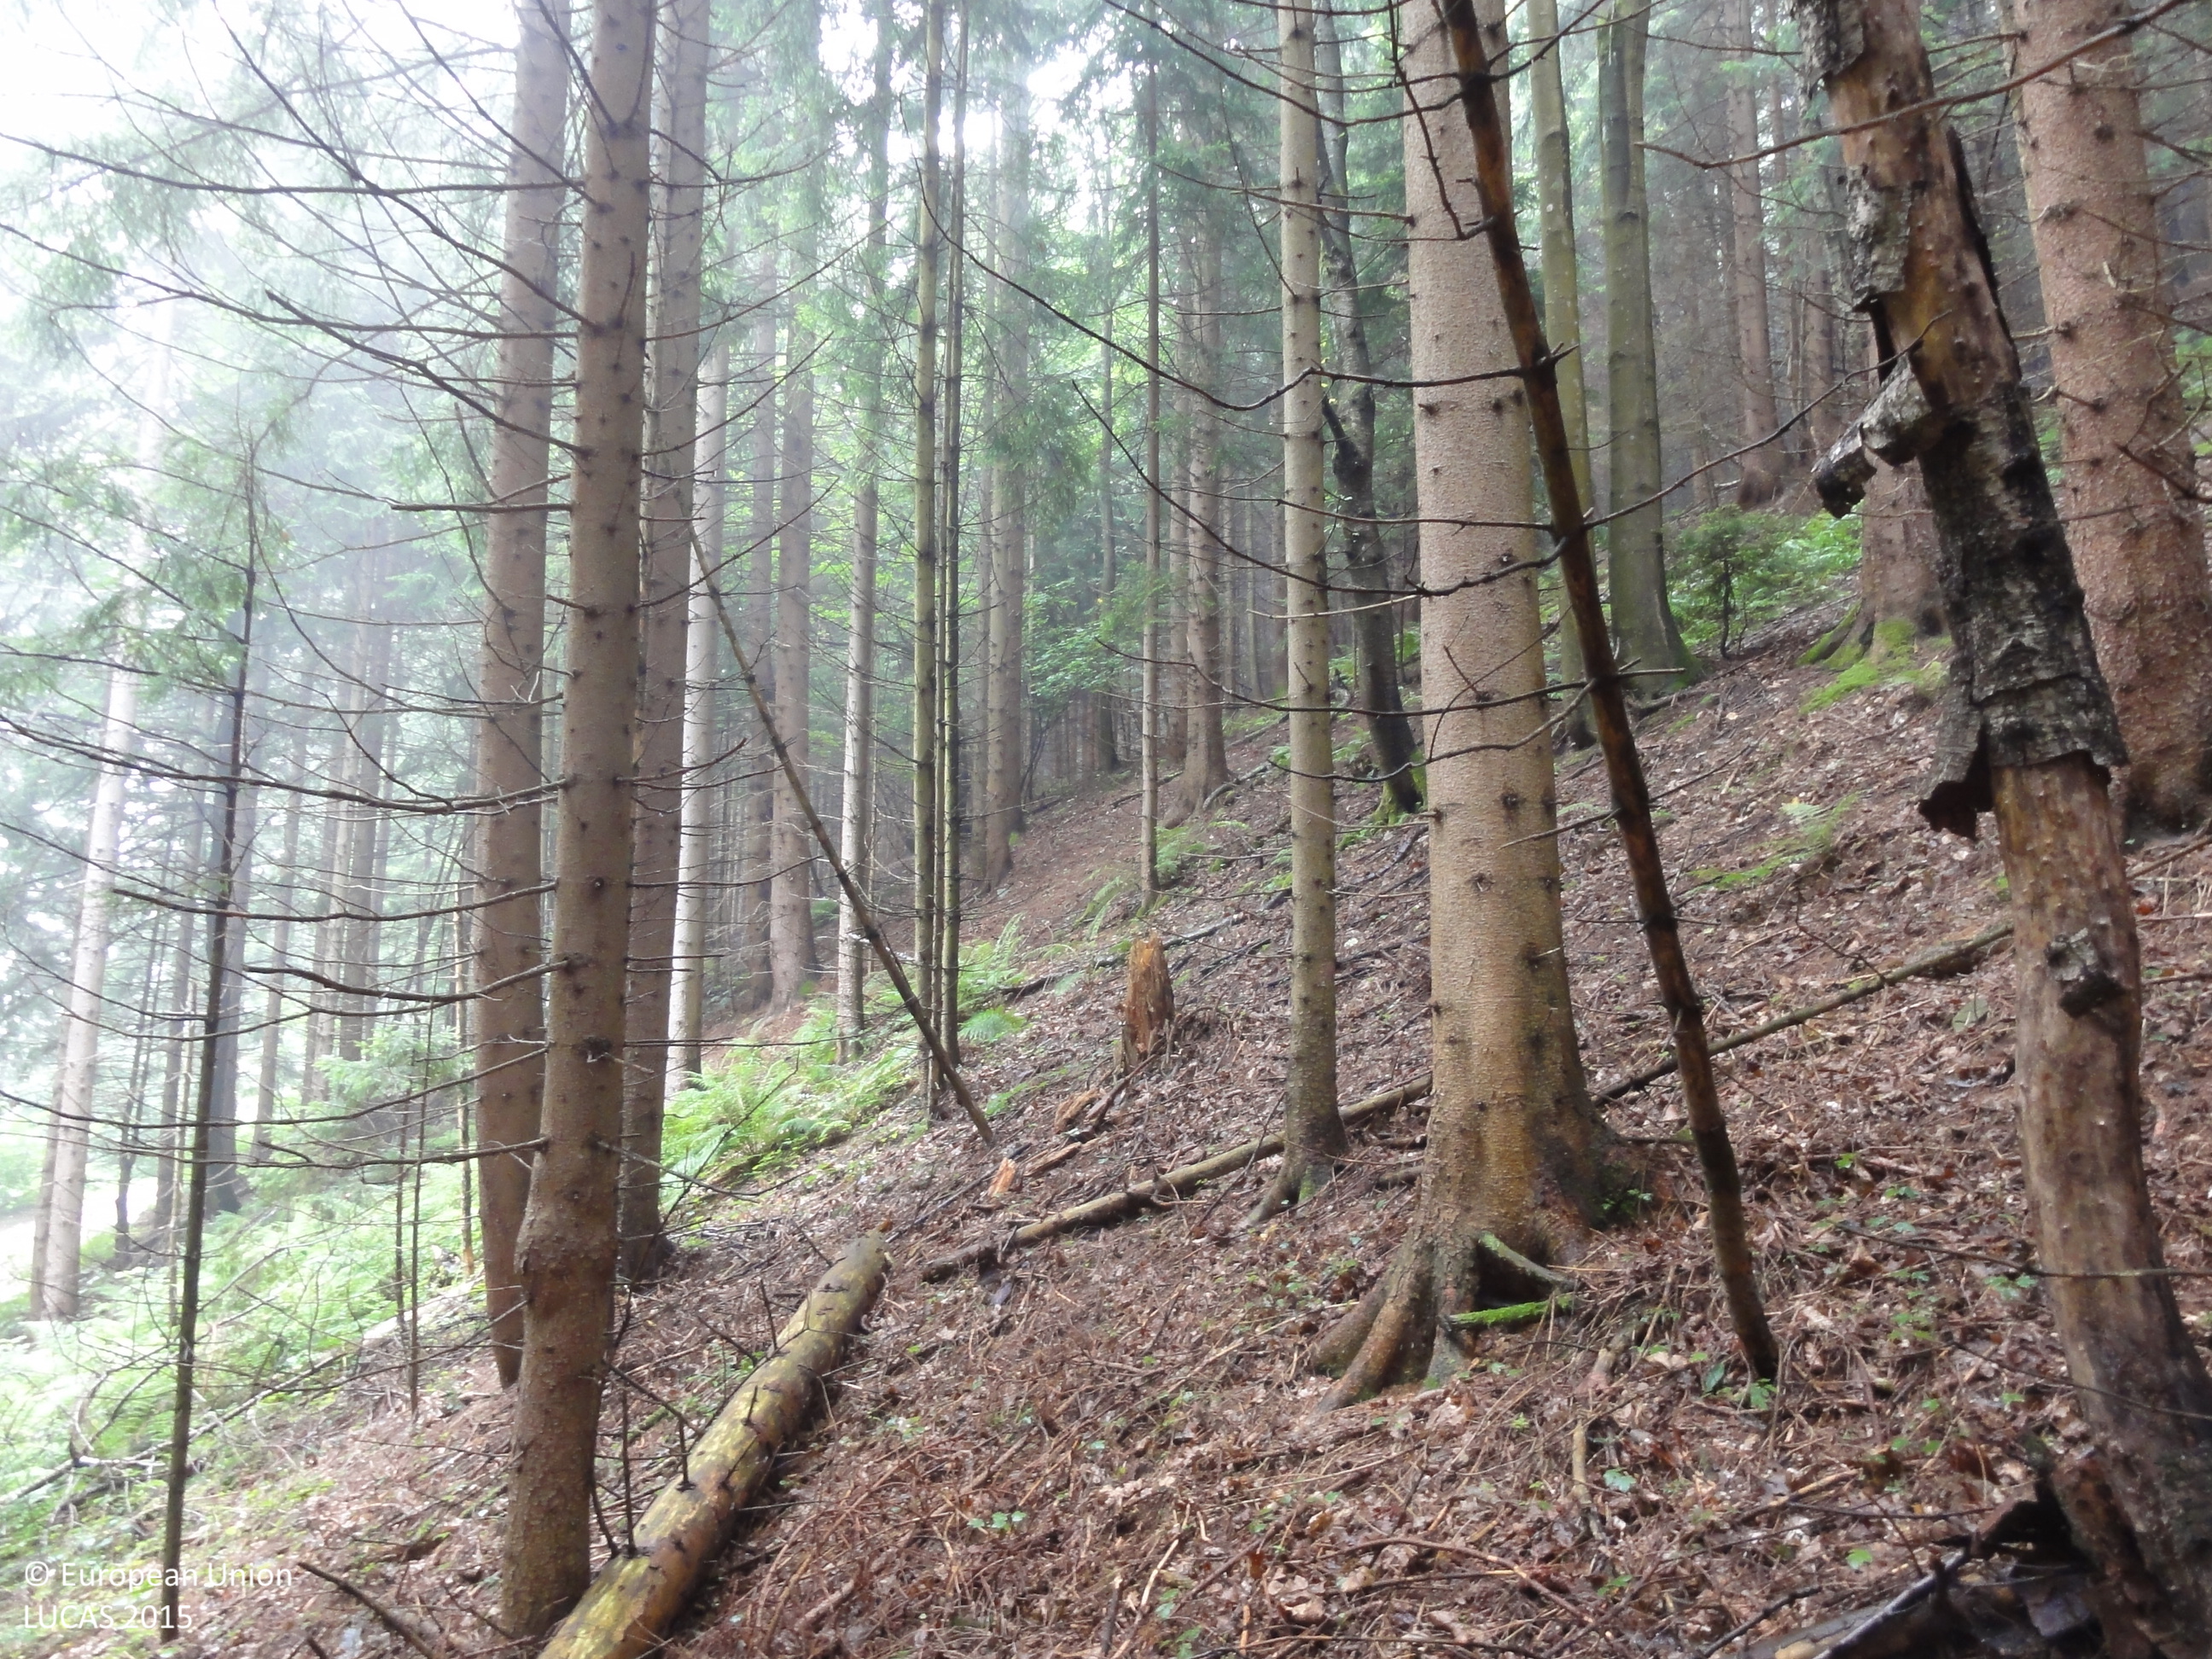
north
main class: Woodland
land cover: Spruce dominated mixed woodland
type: mountainous beech forest
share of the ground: > 75 %
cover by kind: coniferous forest trees 75 %, broadleaved forest trees 25 %
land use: Forestry
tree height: > 5 m
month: August
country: SI
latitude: 46.3689
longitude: 14.8201
